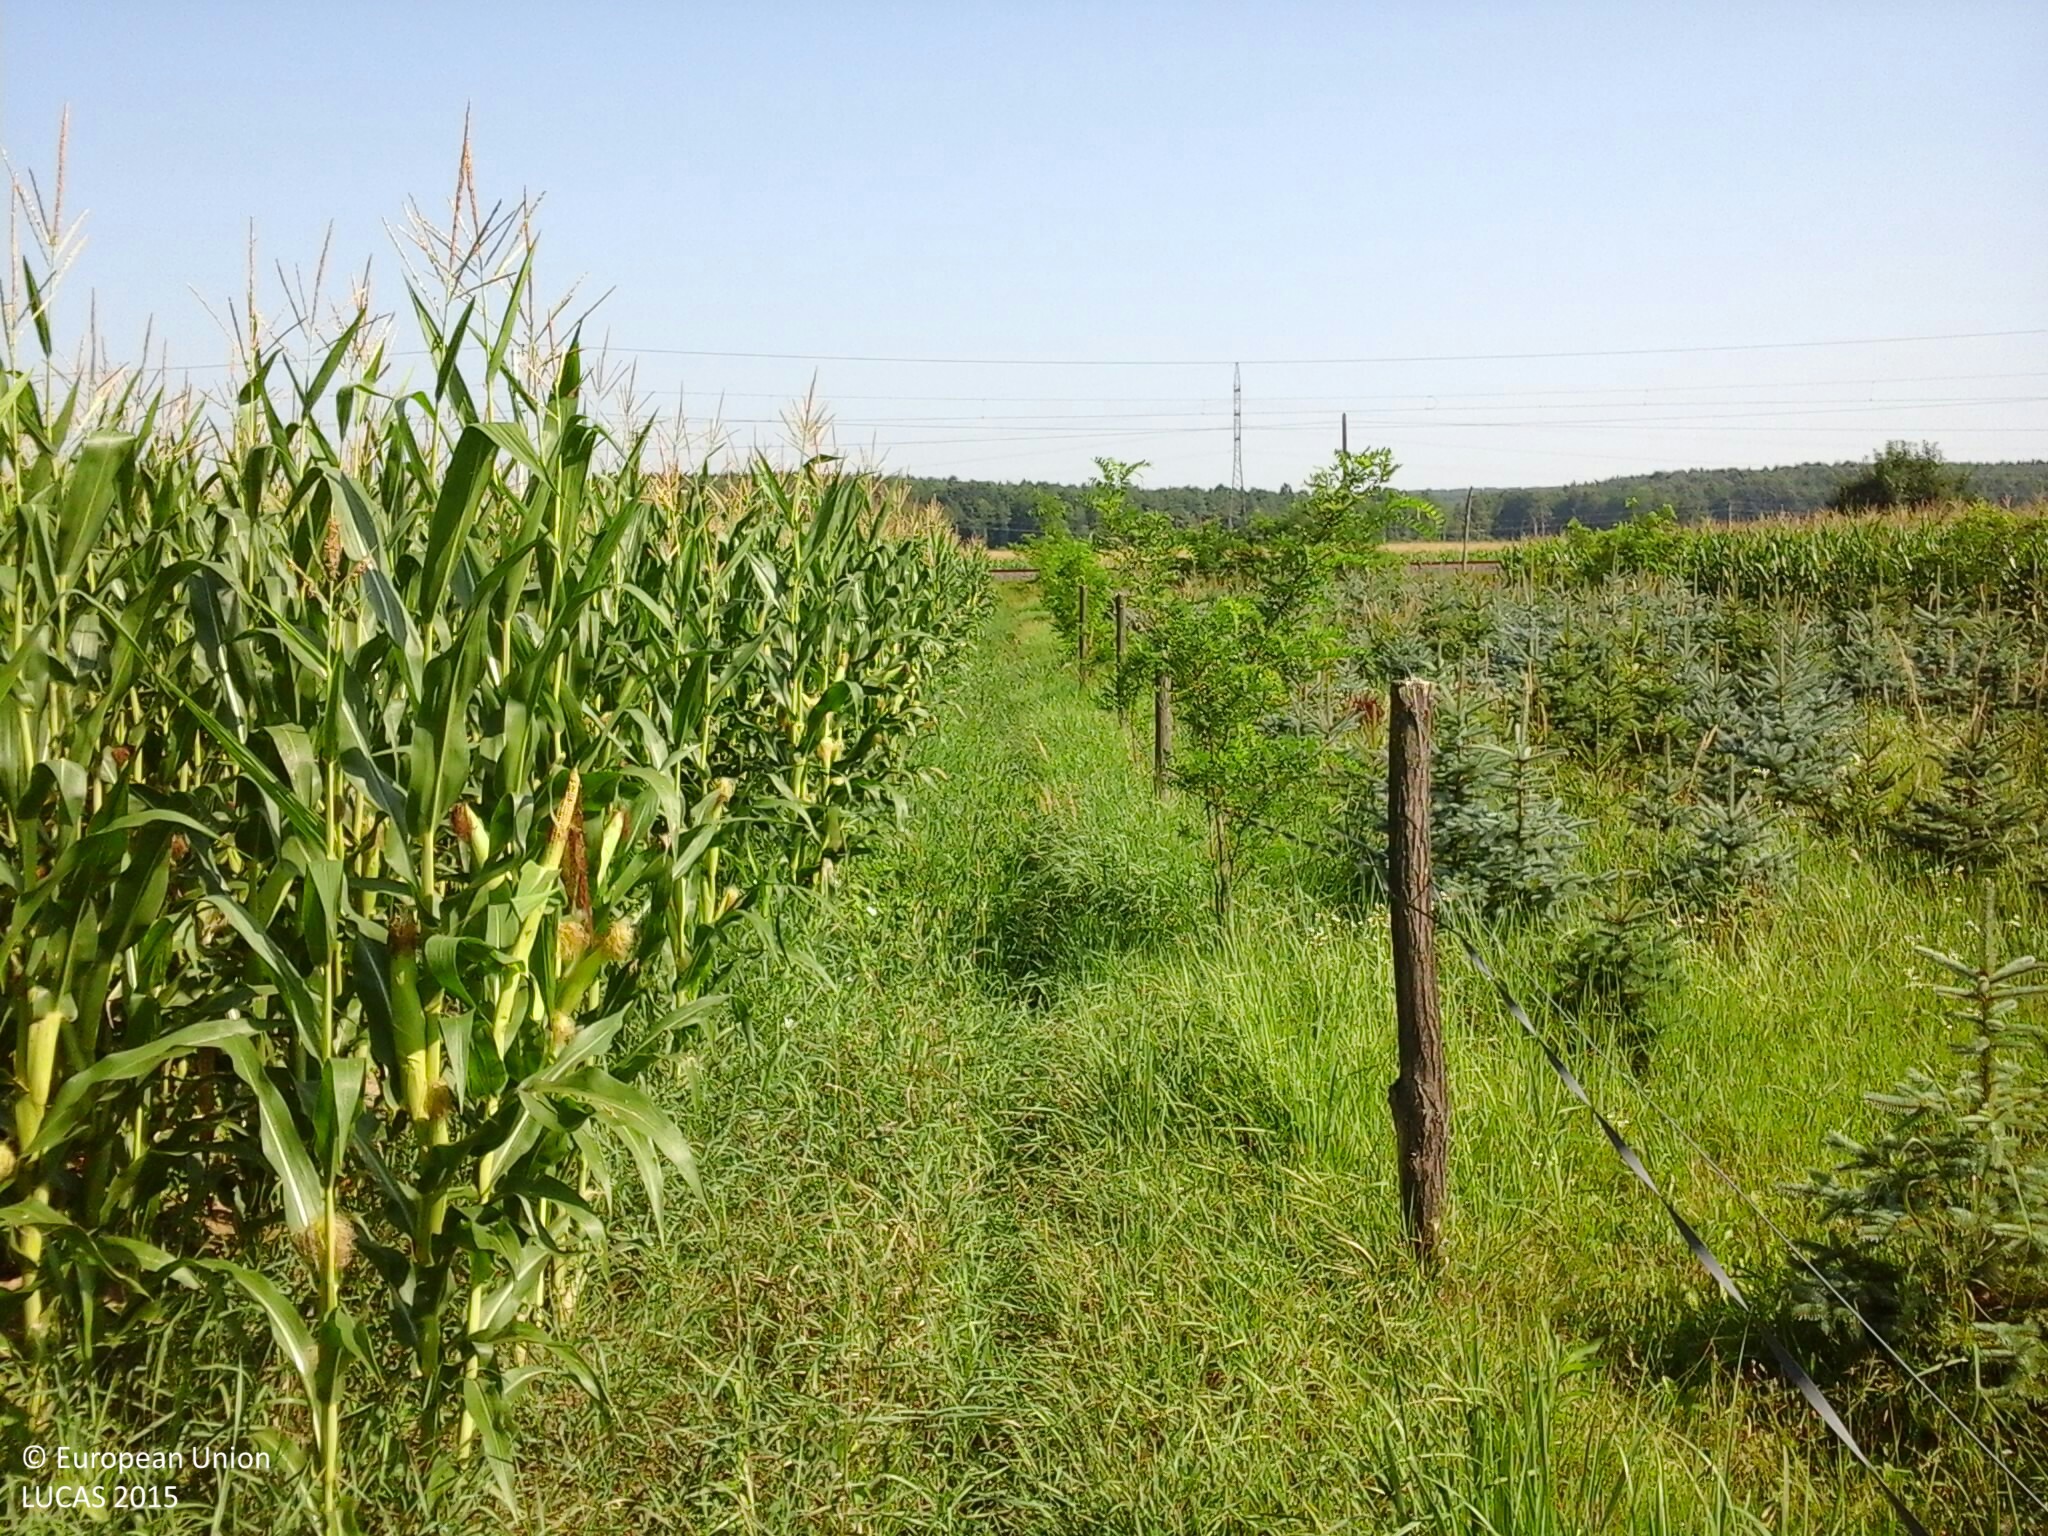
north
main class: Cropland
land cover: Maize
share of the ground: > 75 %
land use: Agriculture (excluding fallow land and kitchen gardens)
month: July
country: HU
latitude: 46.9690
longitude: 16.4558
